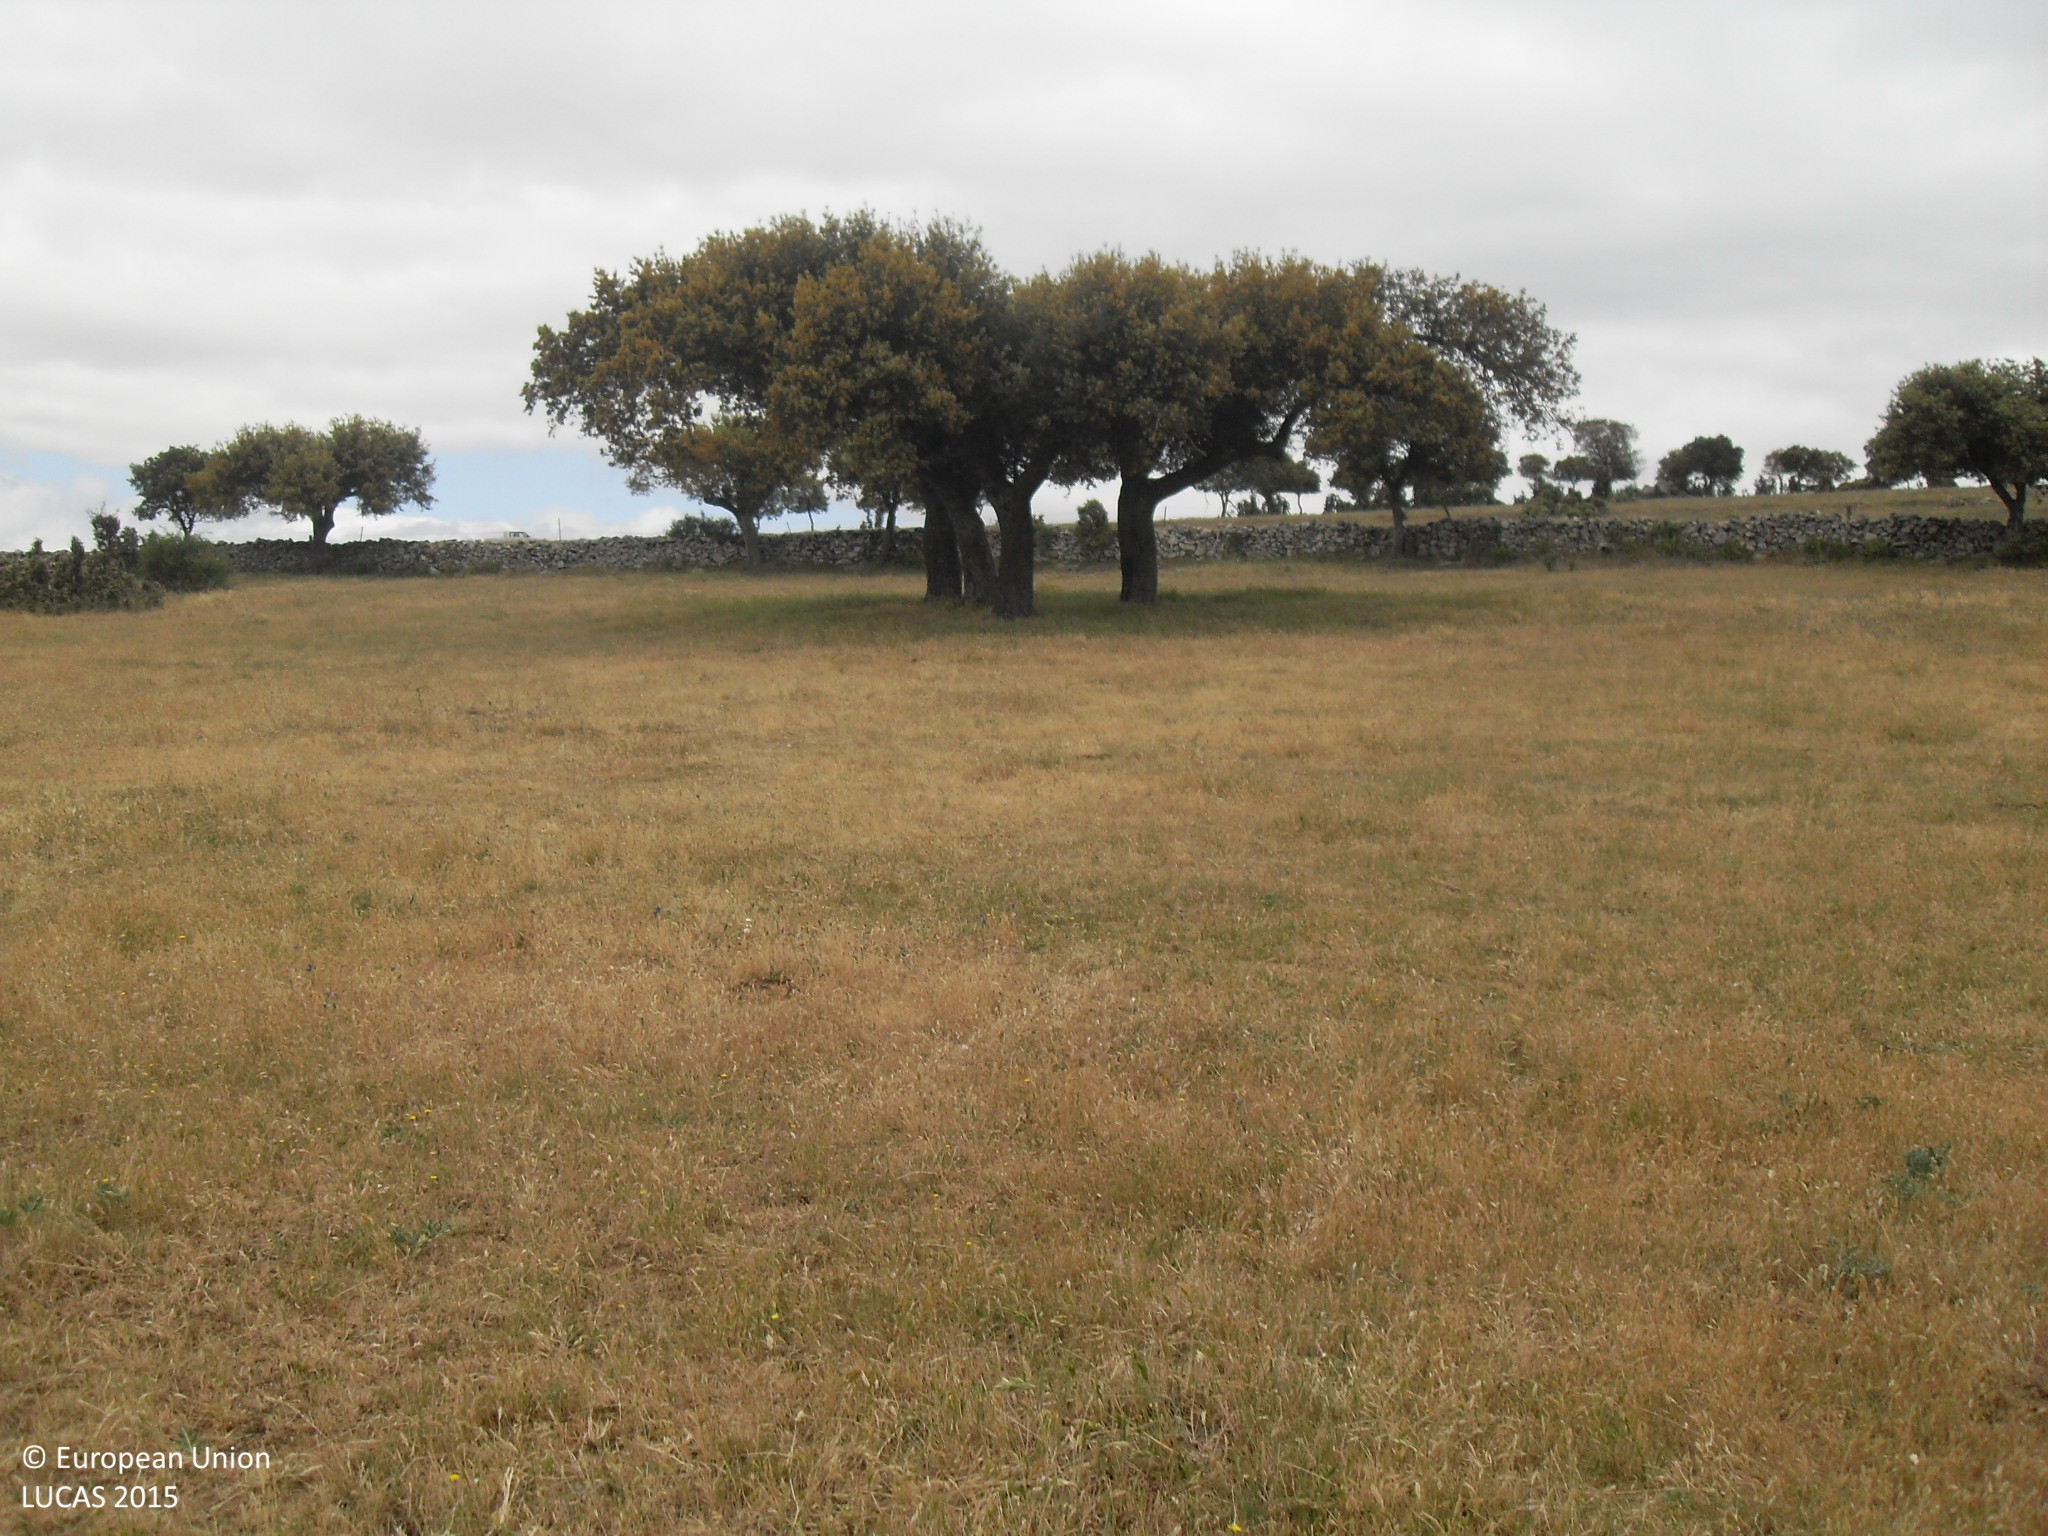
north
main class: Grassland
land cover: Grassland without tree/shrub cover
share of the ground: > 75 %
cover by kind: herbaceous plants 100 %
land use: Agriculture (excluding fallow land and kitchen gardens)
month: May
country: ES
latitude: 40.6081
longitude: -5.6127
